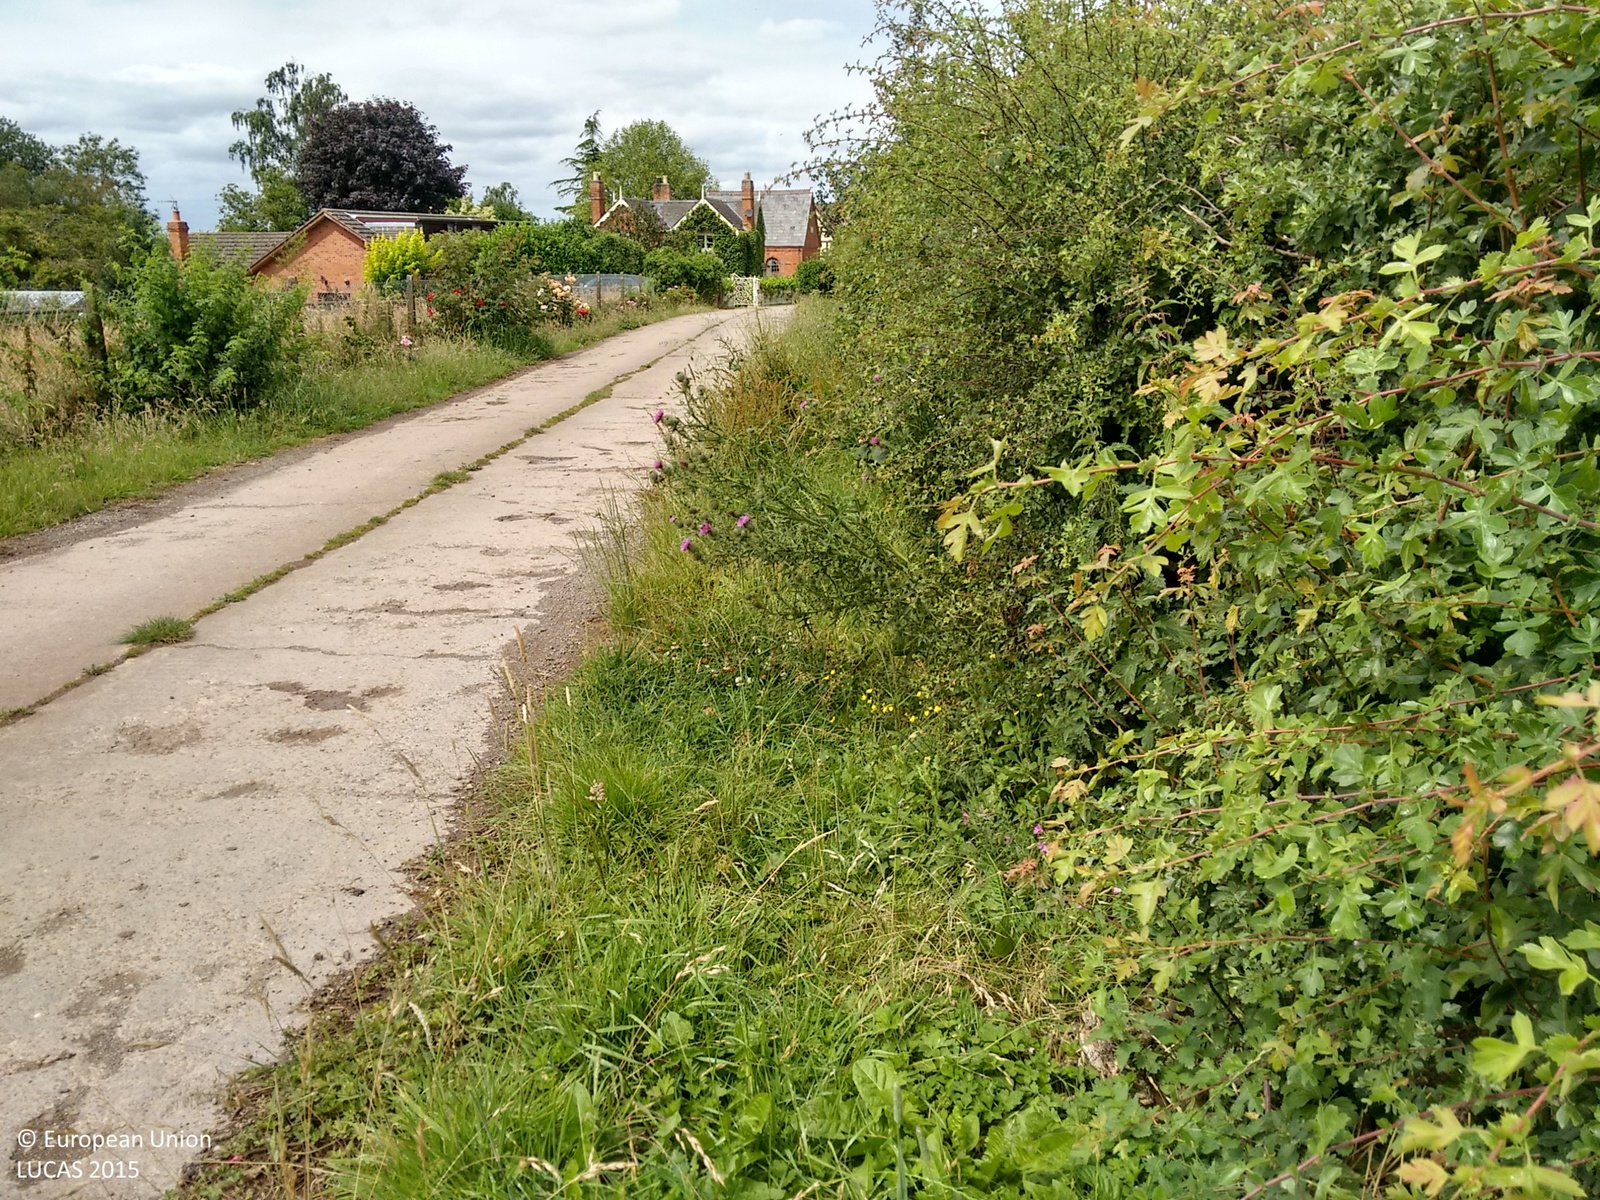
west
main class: Cropland
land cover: Common wheat
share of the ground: > 75 %
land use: Agriculture (excluding fallow land and kitchen gardens)
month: July
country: GB
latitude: 52.1292
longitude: -2.5275
